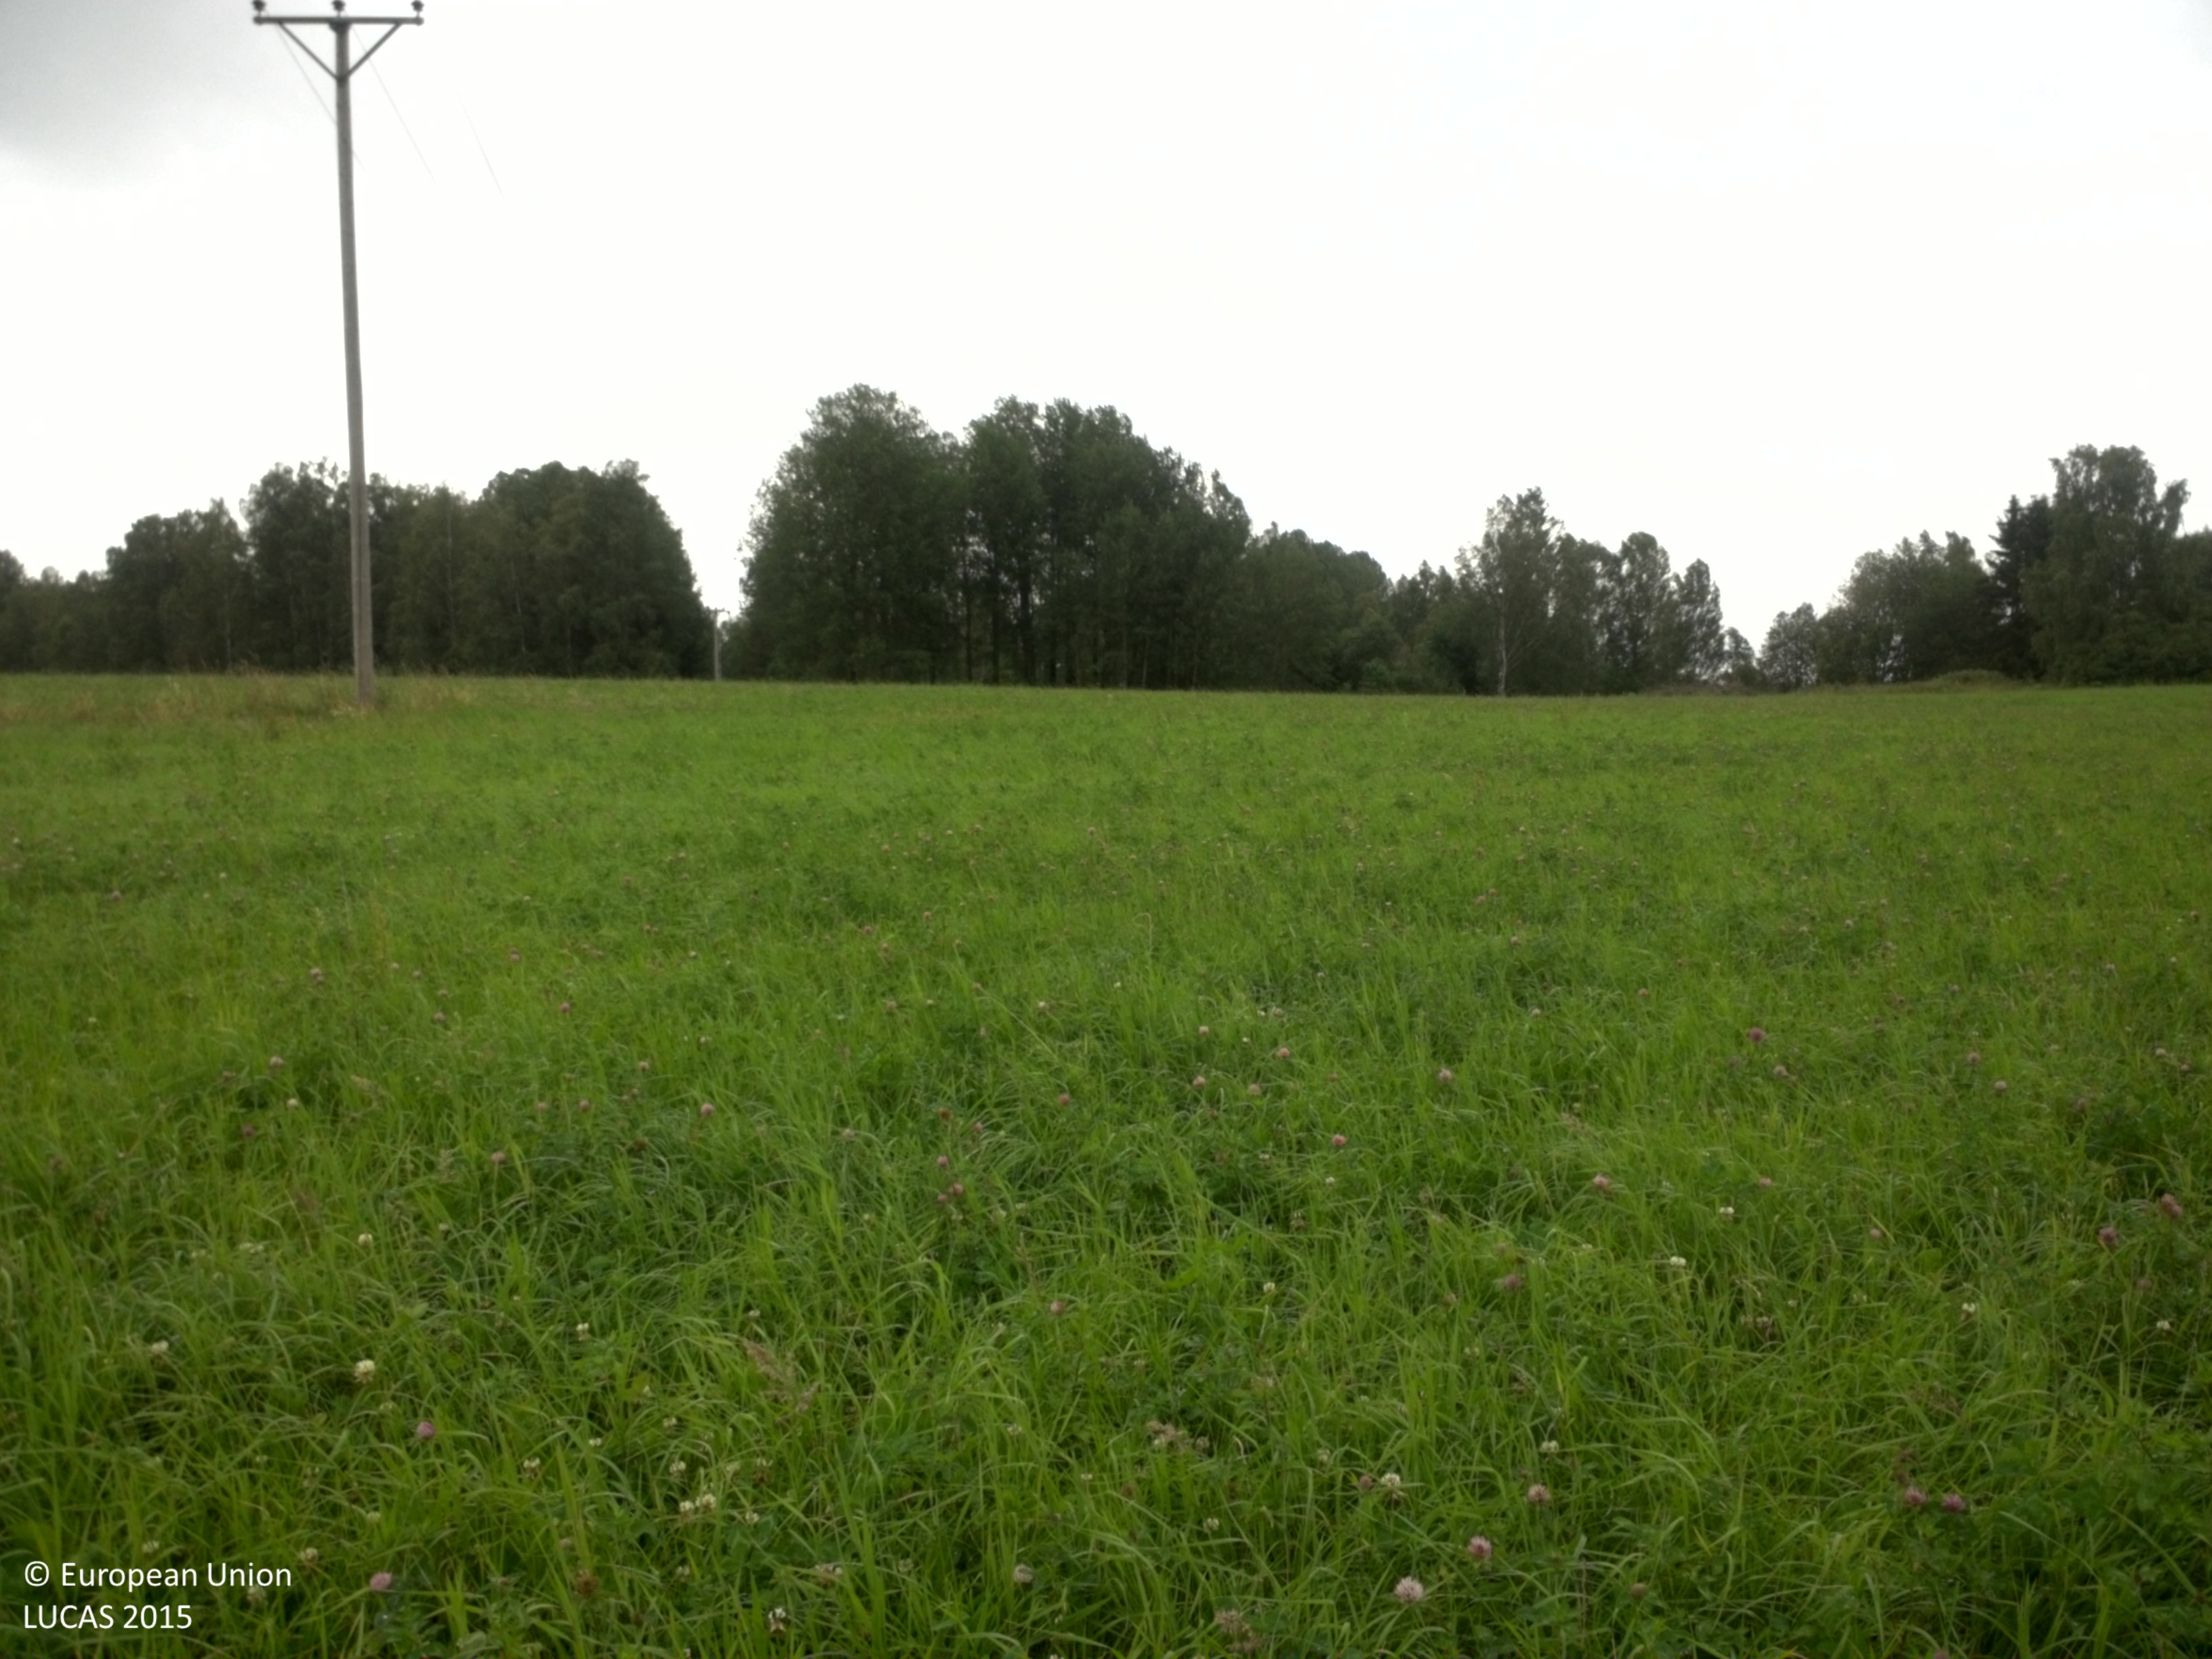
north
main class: Cropland
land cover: Other leguminous and mixtures for fodder
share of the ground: > 75 %
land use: Agriculture (excluding fallow land and kitchen gardens)
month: July
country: SE
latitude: 59.4226
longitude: 13.2528
